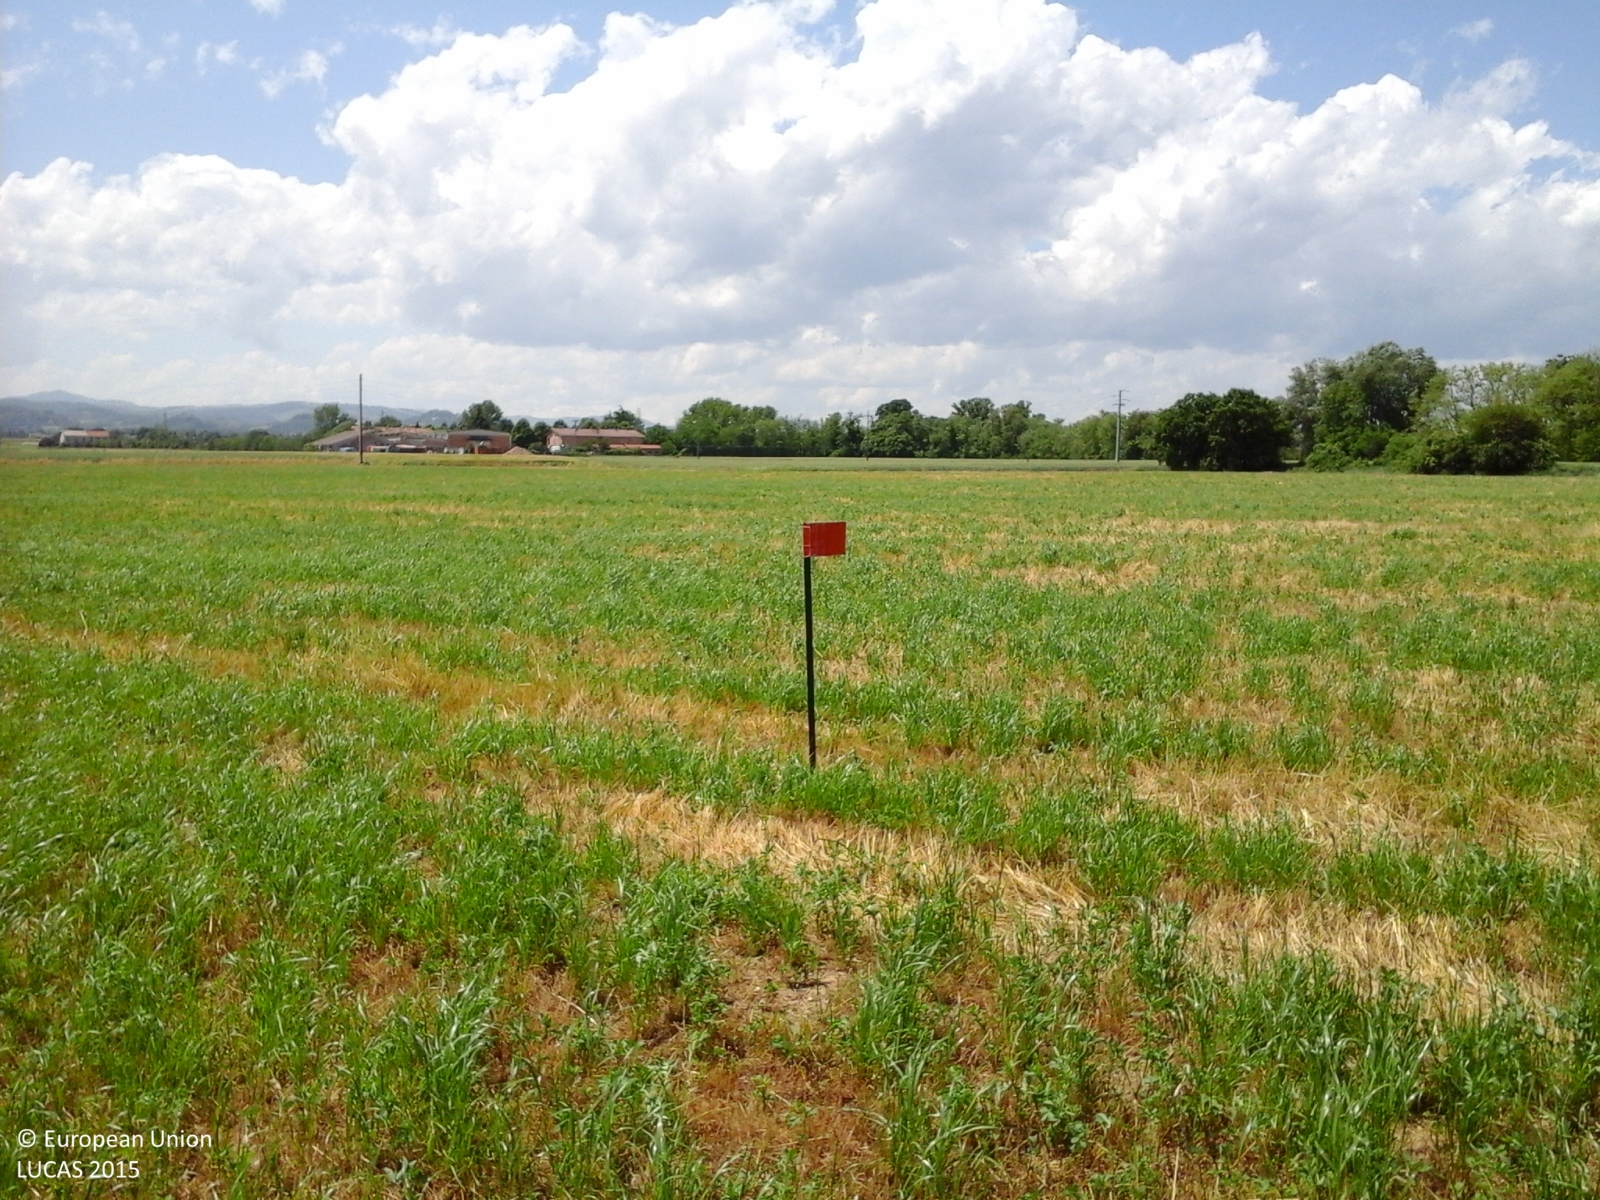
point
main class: Cropland
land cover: Lucerne
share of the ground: > 75 %
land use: Agriculture (excluding fallow land and kitchen gardens)
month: May
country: IT
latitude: 44.6552
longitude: 10.6418
